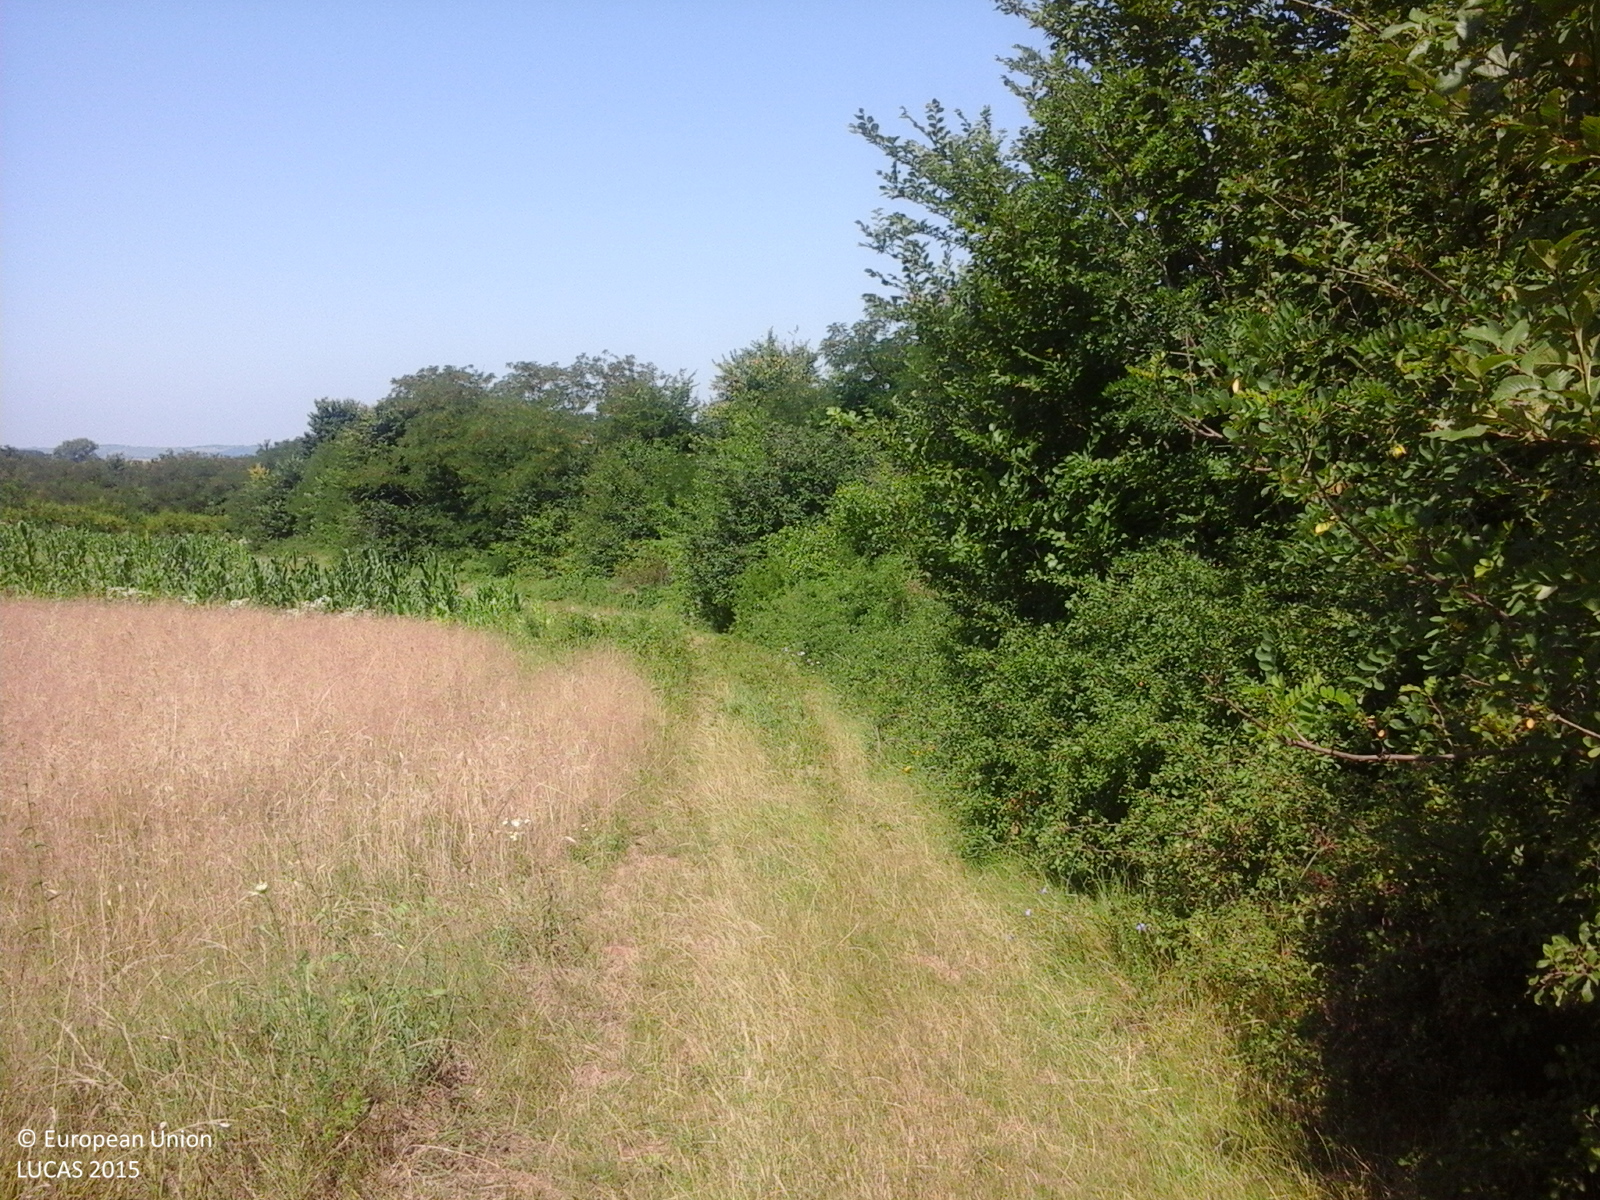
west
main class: Woodland
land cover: Broadleaved woodland
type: exotic forest
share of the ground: > 75 %
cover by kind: broadleaved forest trees 100 %
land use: Forestry
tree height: > 5 m
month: July
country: RO
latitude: 44.7194
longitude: 24.3483
